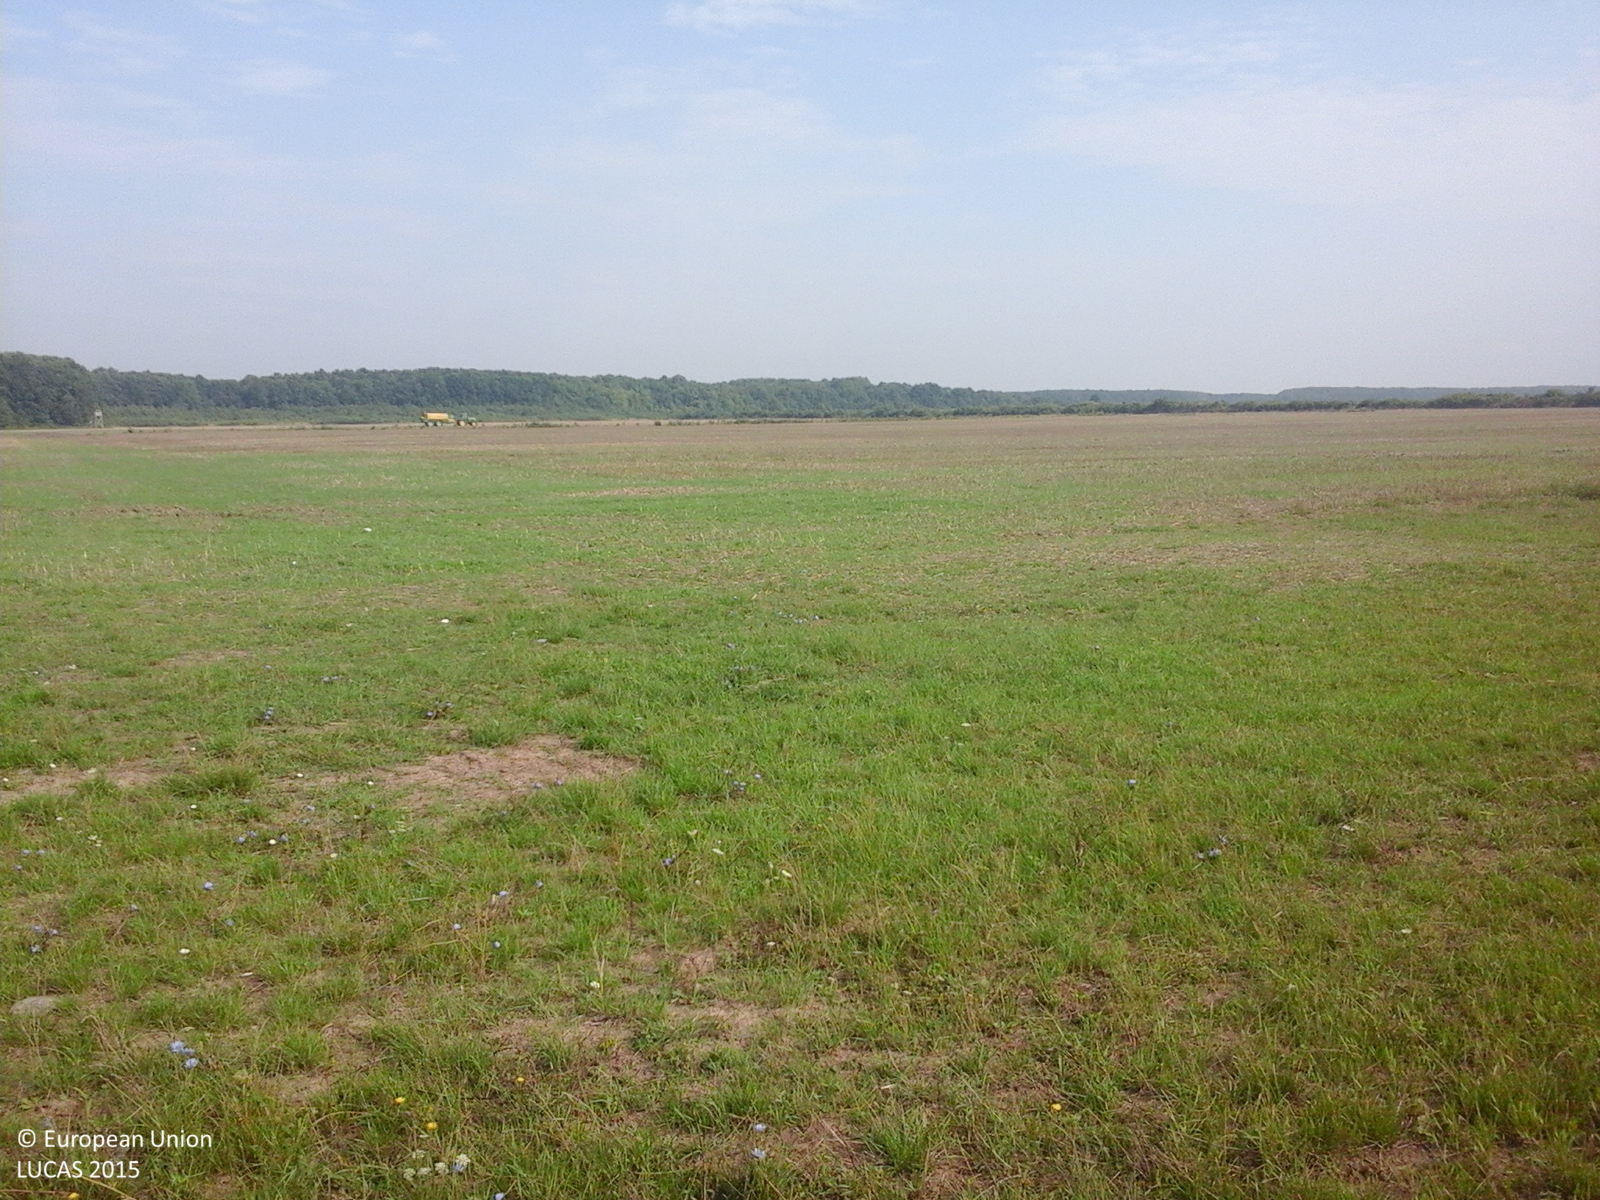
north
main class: Grassland
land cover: Grassland without tree/shrub cover
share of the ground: > 75 %
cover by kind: herbaceous plants 100 %
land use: Agriculture (excluding fallow land and kitchen gardens)
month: August
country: RO
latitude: 46.5506
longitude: 21.6344
